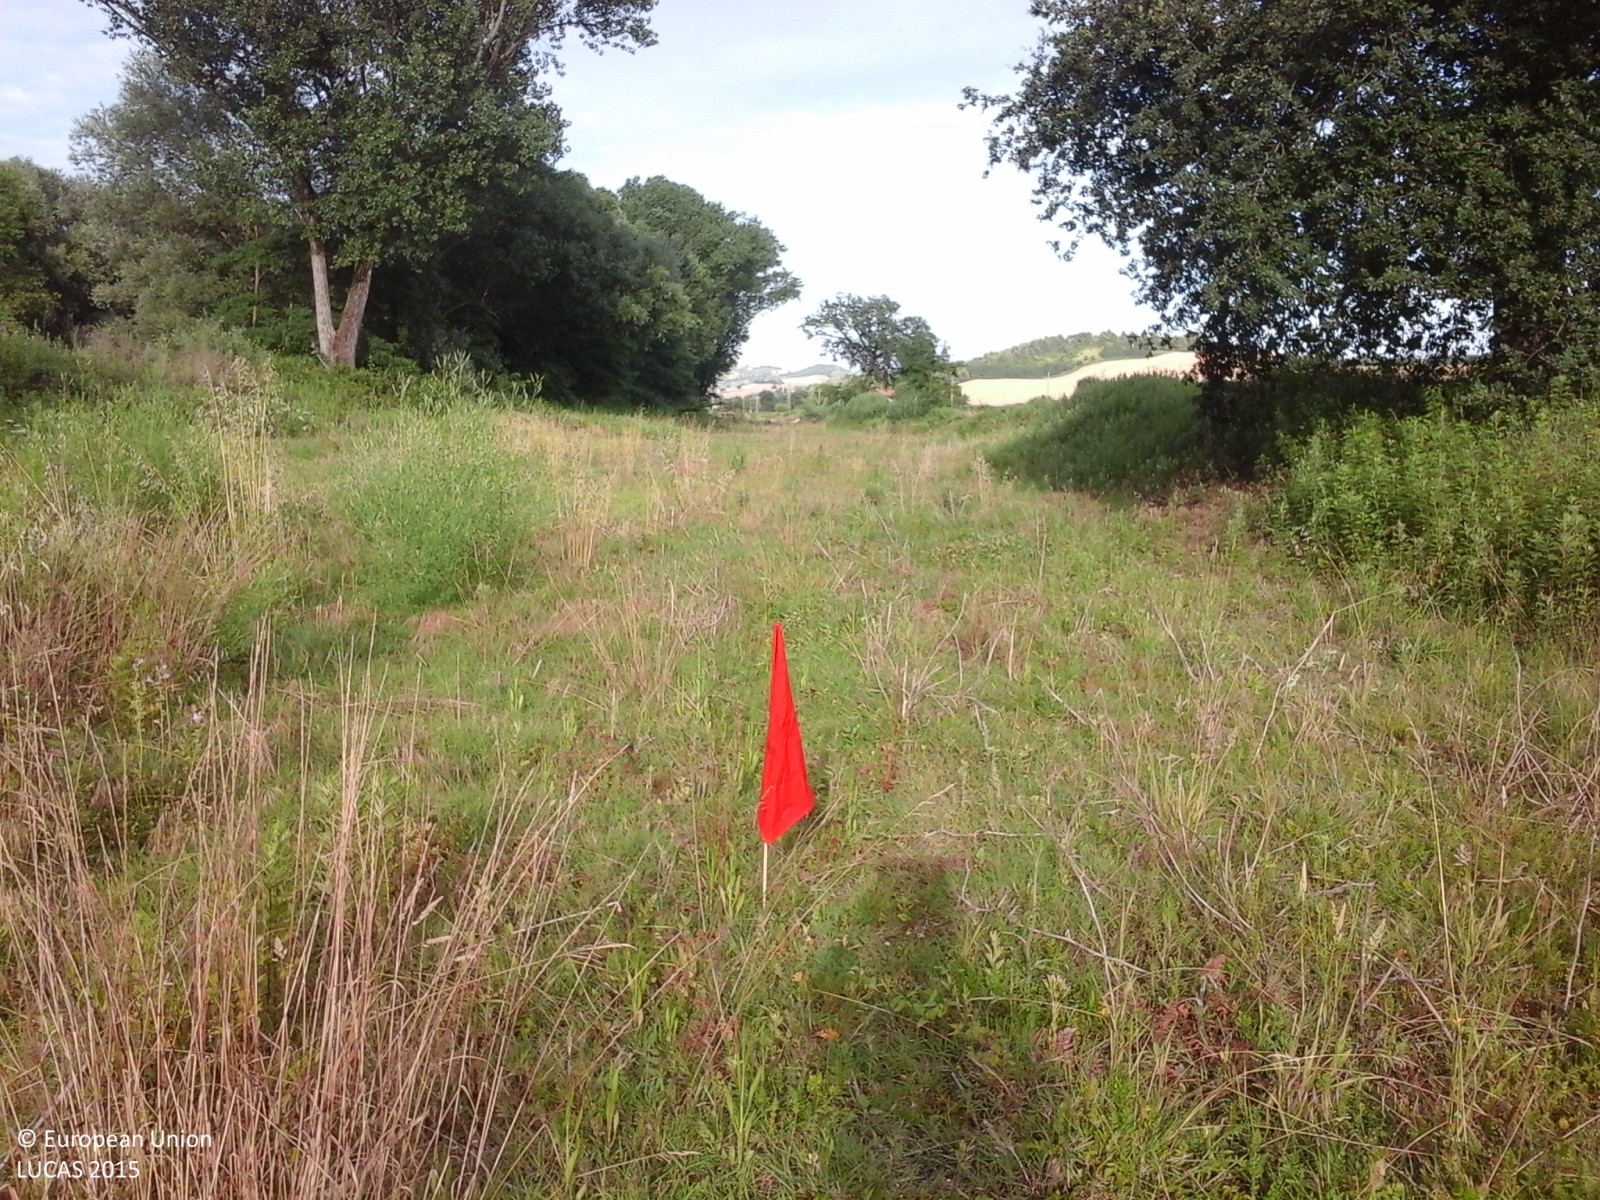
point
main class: Grassland
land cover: Grassland without tree/shrub cover
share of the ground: 50 - 75 %
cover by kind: herbaceous plants 100 %
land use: Agriculture (excluding fallow land and kitchen gardens)
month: June
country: IT
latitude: 43.3531
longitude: 13.4828
